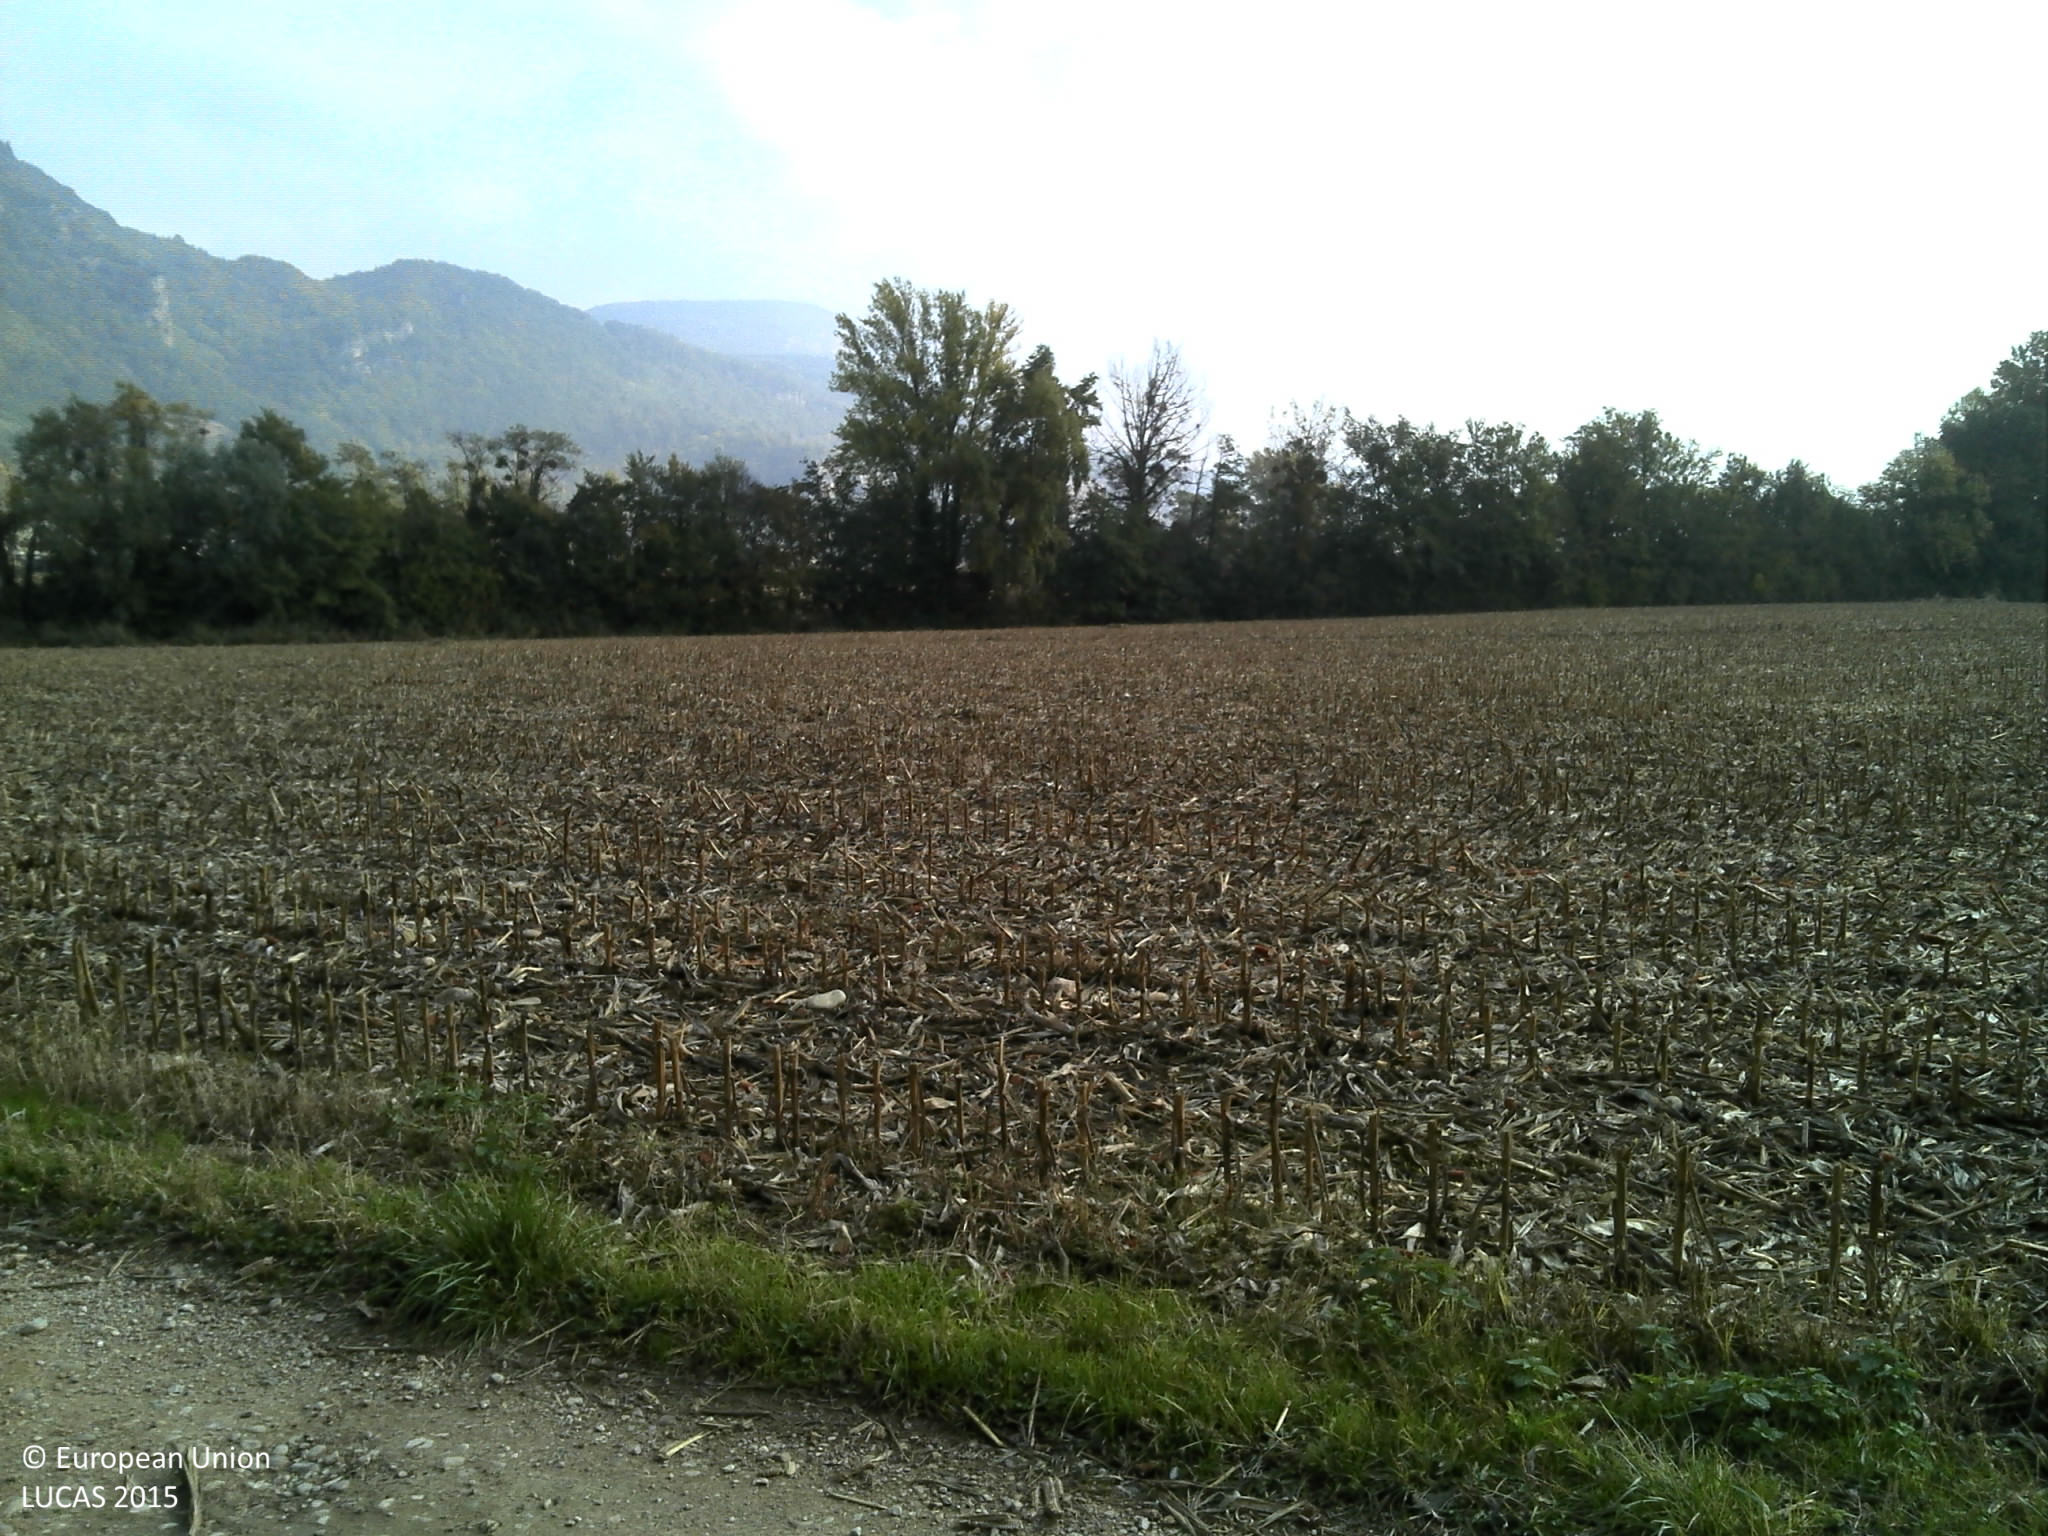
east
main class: Cropland
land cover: Maize
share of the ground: < 10 %
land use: Agriculture (excluding fallow land and kitchen gardens)
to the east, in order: Grass margins; Tracks; Grass margins; Electric lines; Maize; Tracks; Maize; Tracks; Maize; Grassland without tree/shrub cover; Broadleaved woodland; Rivers and streams; Broadleaved woodland; Grassland without tree/shrub cover; Maize; Managed hedges; Grass margins; Tracks; Grass margins; Other bare soil
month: October
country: FR
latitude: 45.8893
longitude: 5.3516
